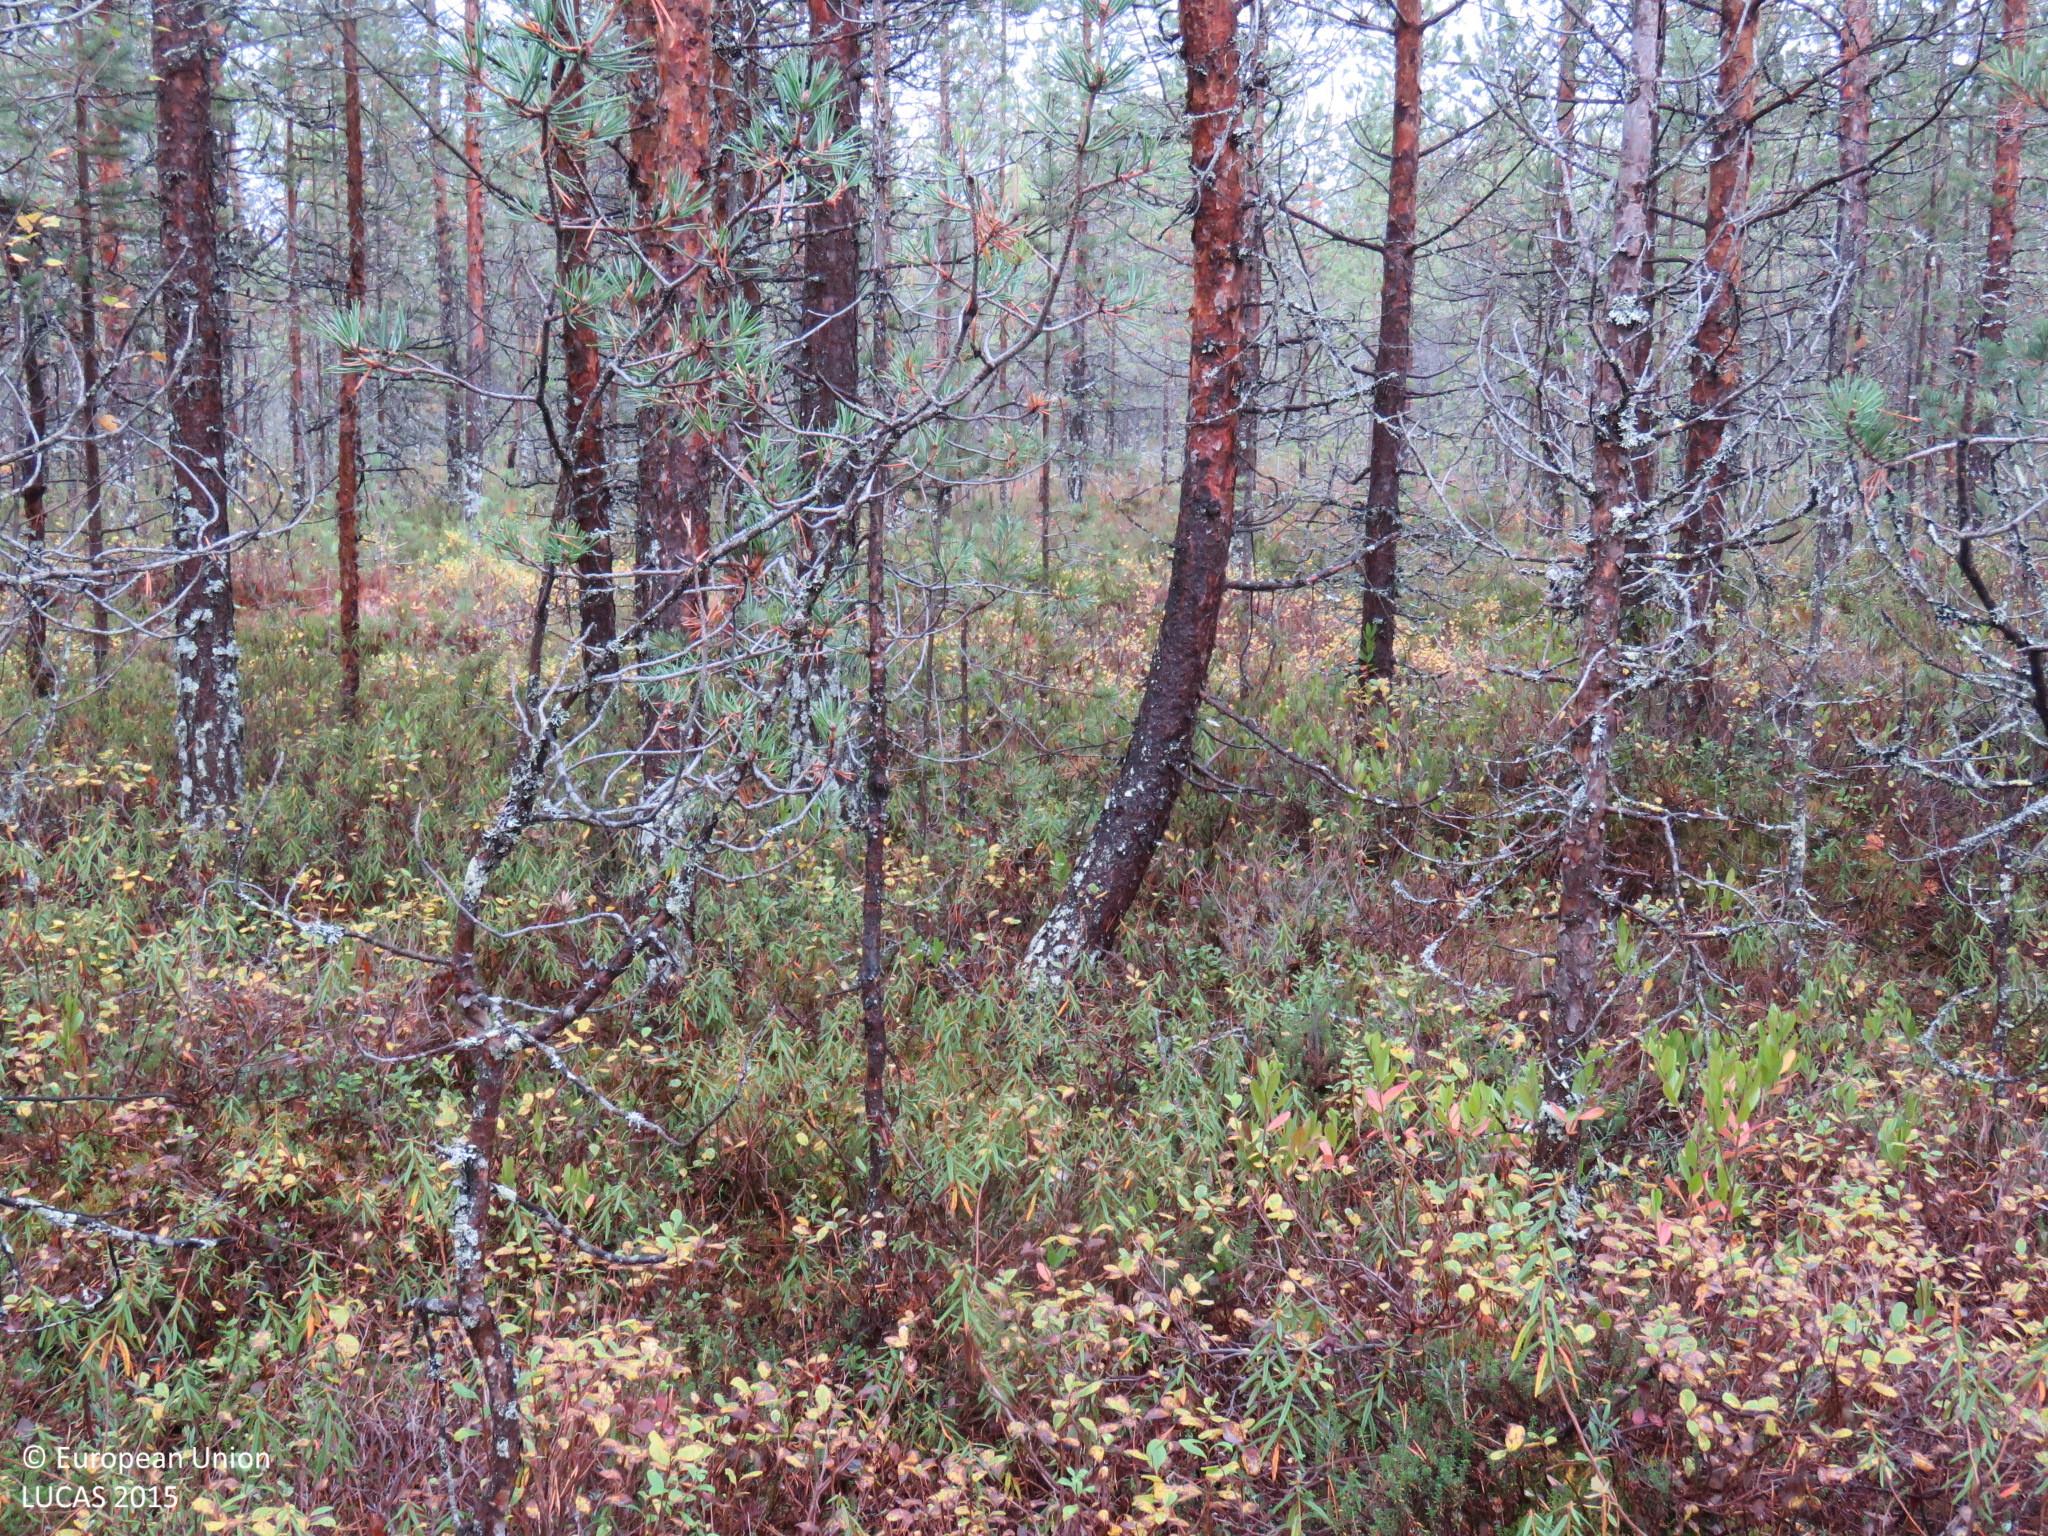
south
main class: Woodland
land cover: Pine dominated coniferous woodland
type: boreal forest
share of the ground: > 75 %
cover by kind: coniferous forest trees 80 %, shrubs 15 %, lichens and mosses 5 %
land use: Forestry
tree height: > 5 m
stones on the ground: < 10 %
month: September
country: FI
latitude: 65.1487
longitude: 26.7682
